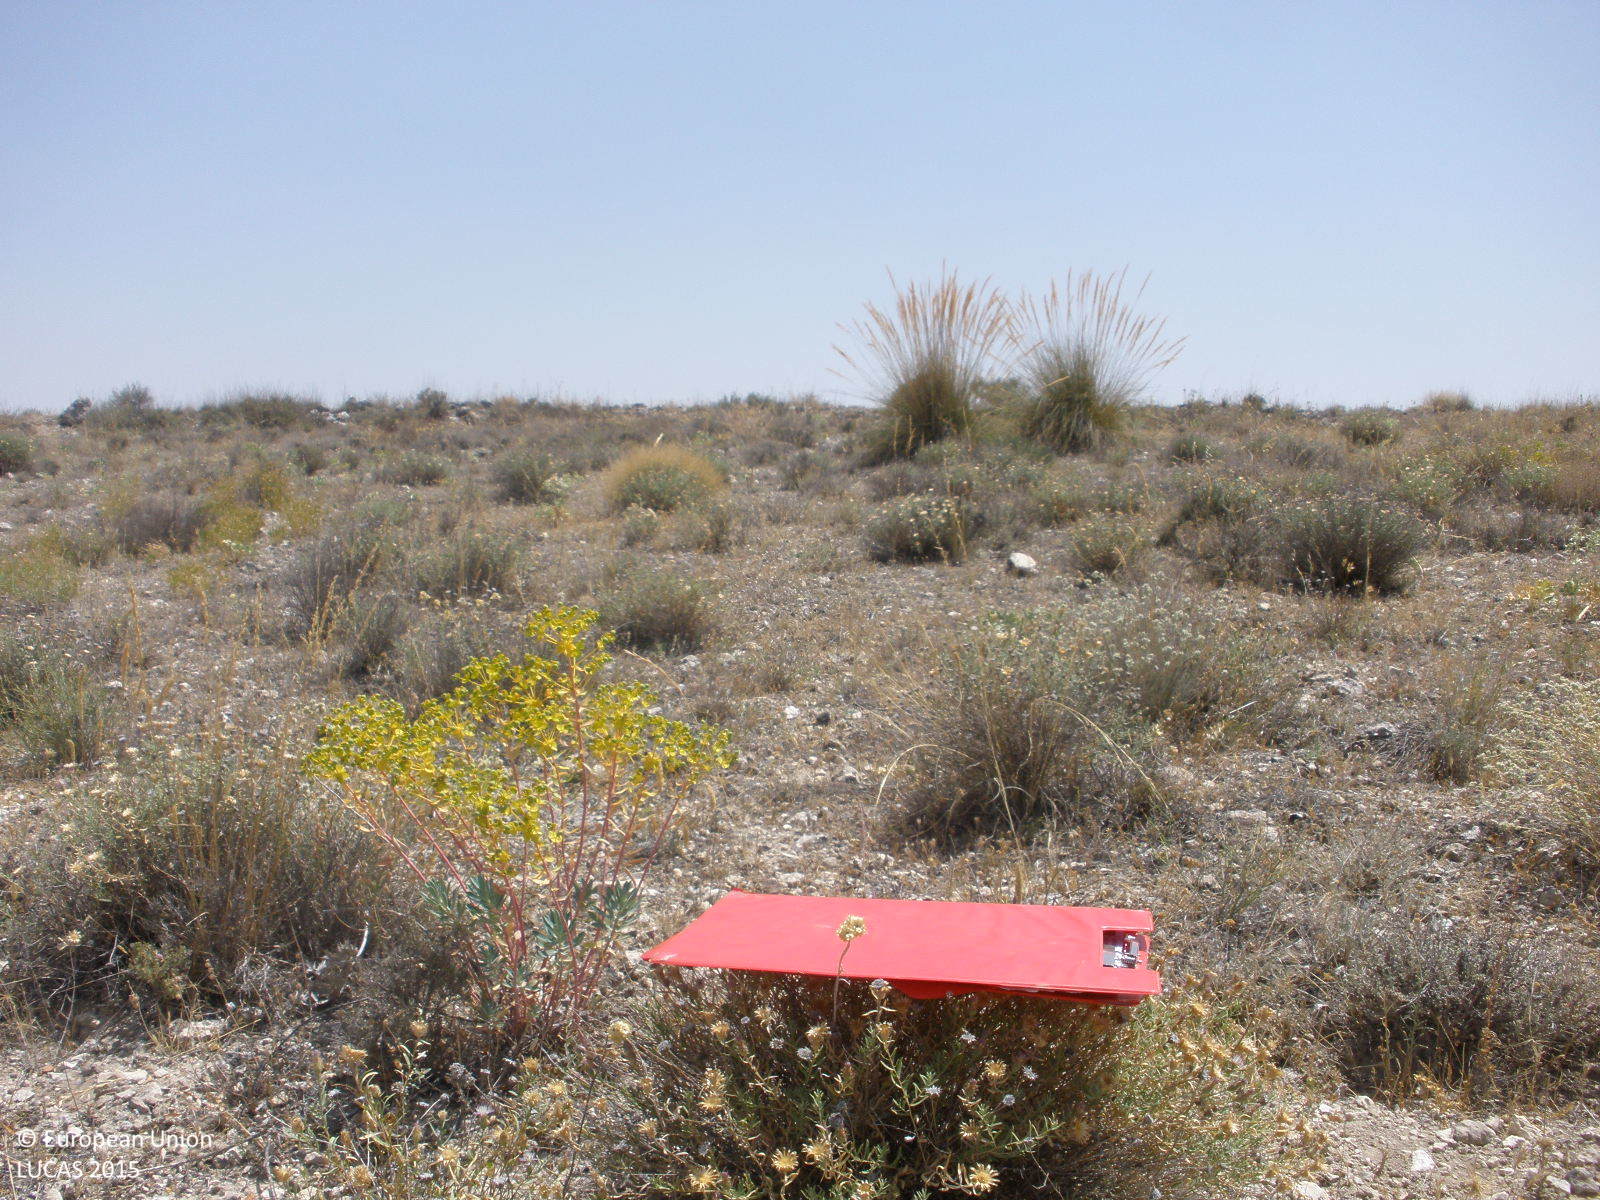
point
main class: Shrubland
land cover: Shrubland without tree cover
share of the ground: 50 - 75 %
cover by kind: shrubs 60 %, herbaceous plants 25 %, consolidated bare surface 15 %
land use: Semi-natural and natural areas not in use
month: July
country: ES
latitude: 39.9870
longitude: -3.2480
